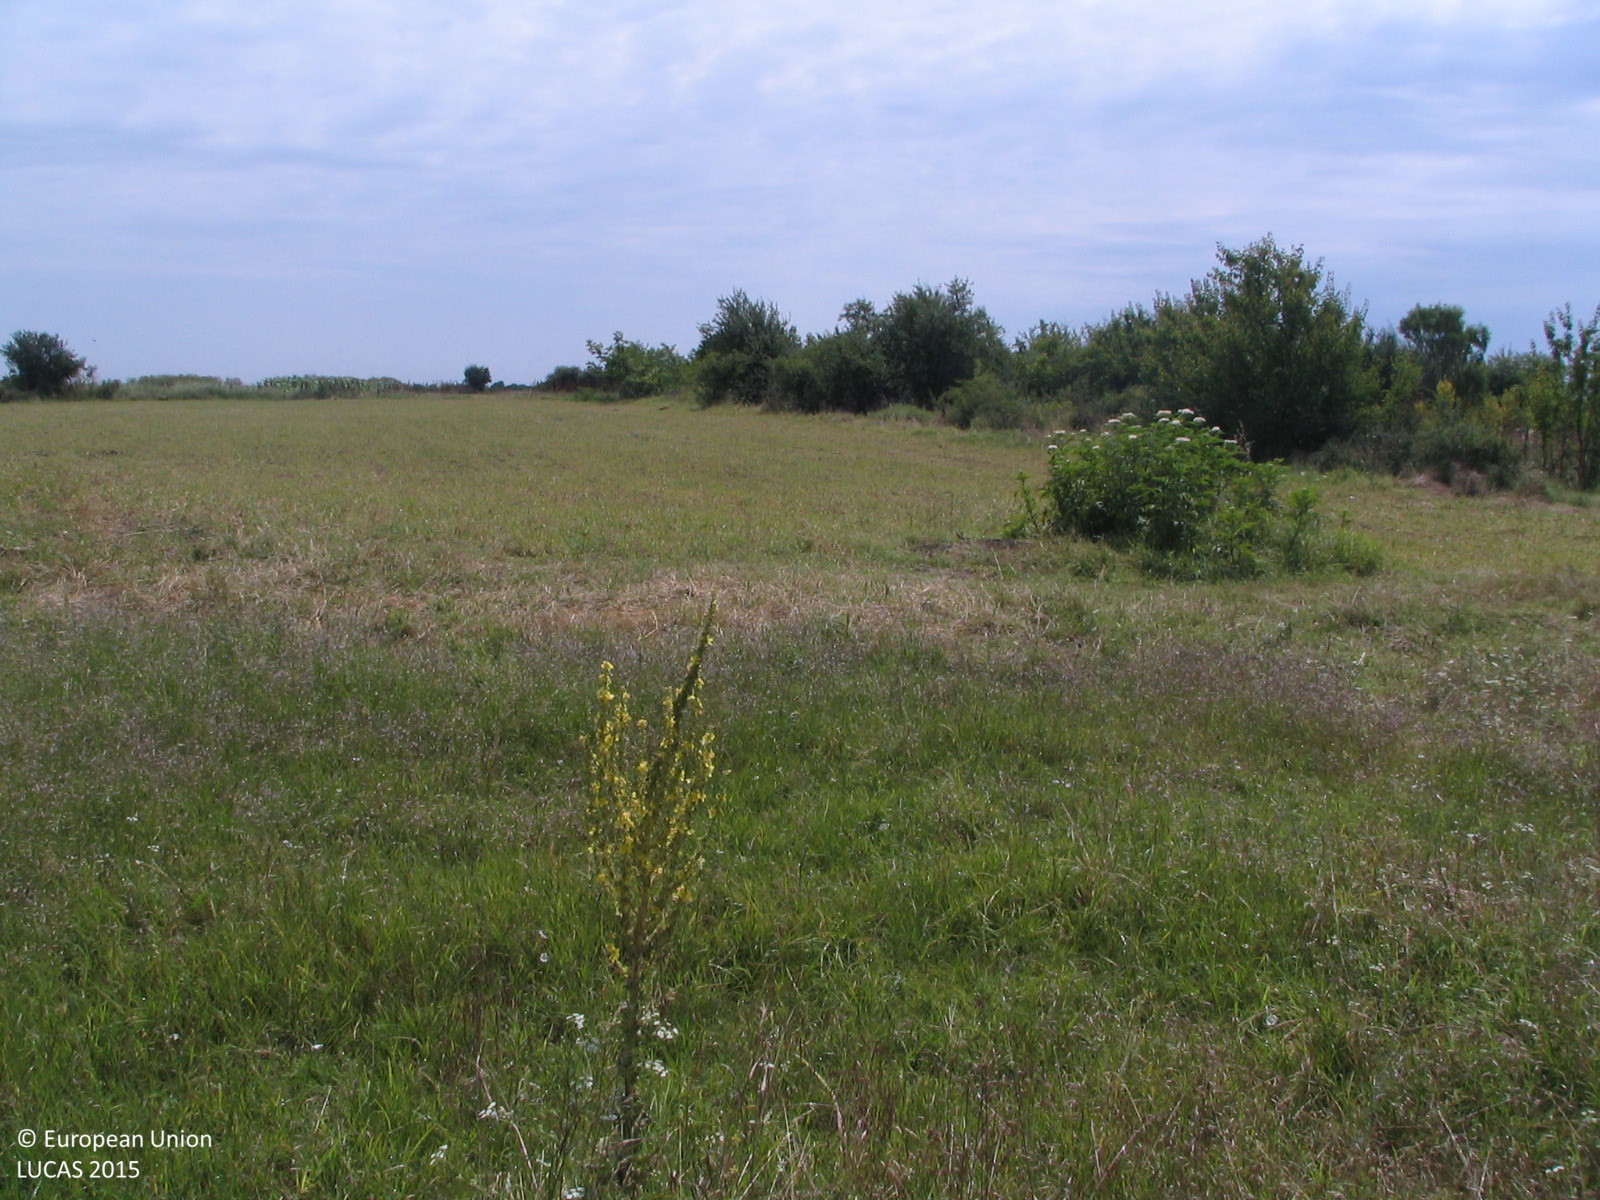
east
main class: Grassland
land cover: Grassland with sparse tree/shrub cover
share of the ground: > 75 %
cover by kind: herbaceous plants 90 %, broadleaved forest trees 5 %, shrubs 5 %
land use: Semi-natural and natural areas not in use
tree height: < 5 m
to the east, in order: Grassland with sparse tree/shrub cover; Barley; Grass margins; Barley; Grassland with sparse tree/shrub cover; Tracks; Common wheat
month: June
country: BG
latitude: 43.4757
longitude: 24.0855
